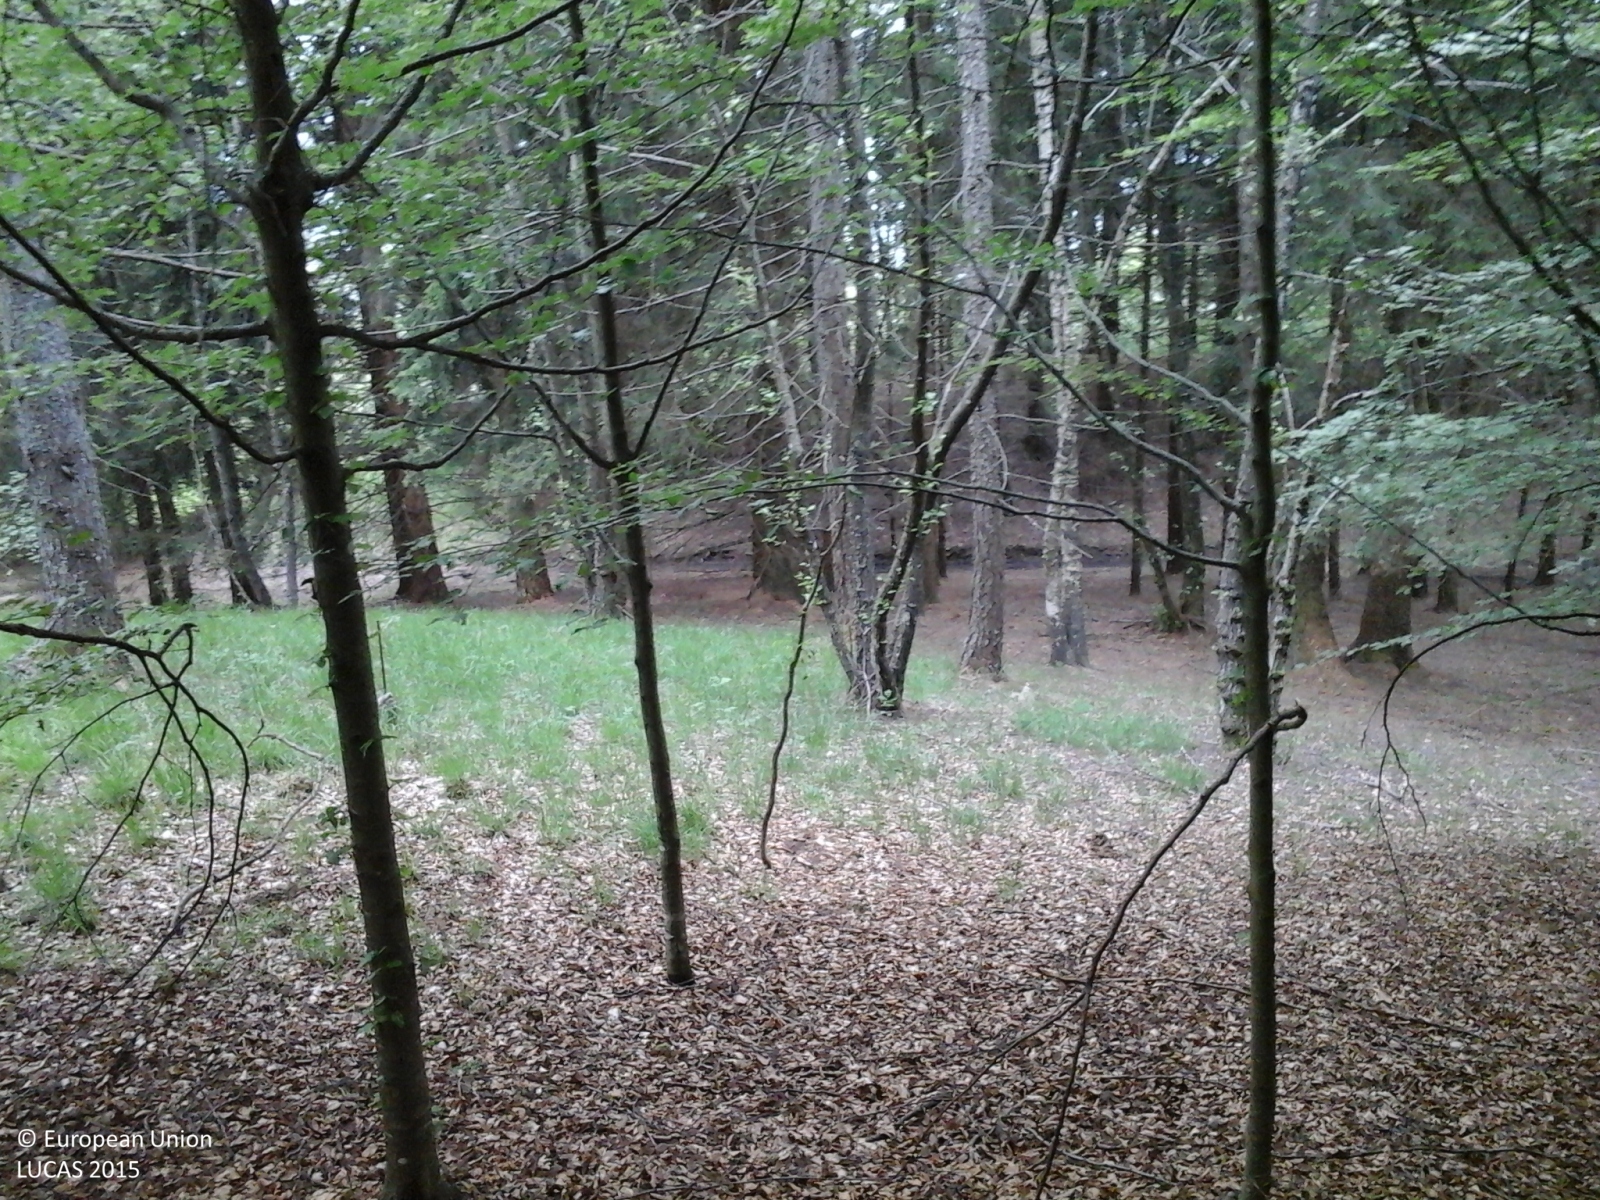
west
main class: Woodland
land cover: Broadleaved woodland
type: mountainous beech forest
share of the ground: > 75 %
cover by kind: broadleaved forest trees 95 %, coniferous forest trees 5 %
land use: Forestry
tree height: > 5 m
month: June
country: IT
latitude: 46.1797
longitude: 12.4195
